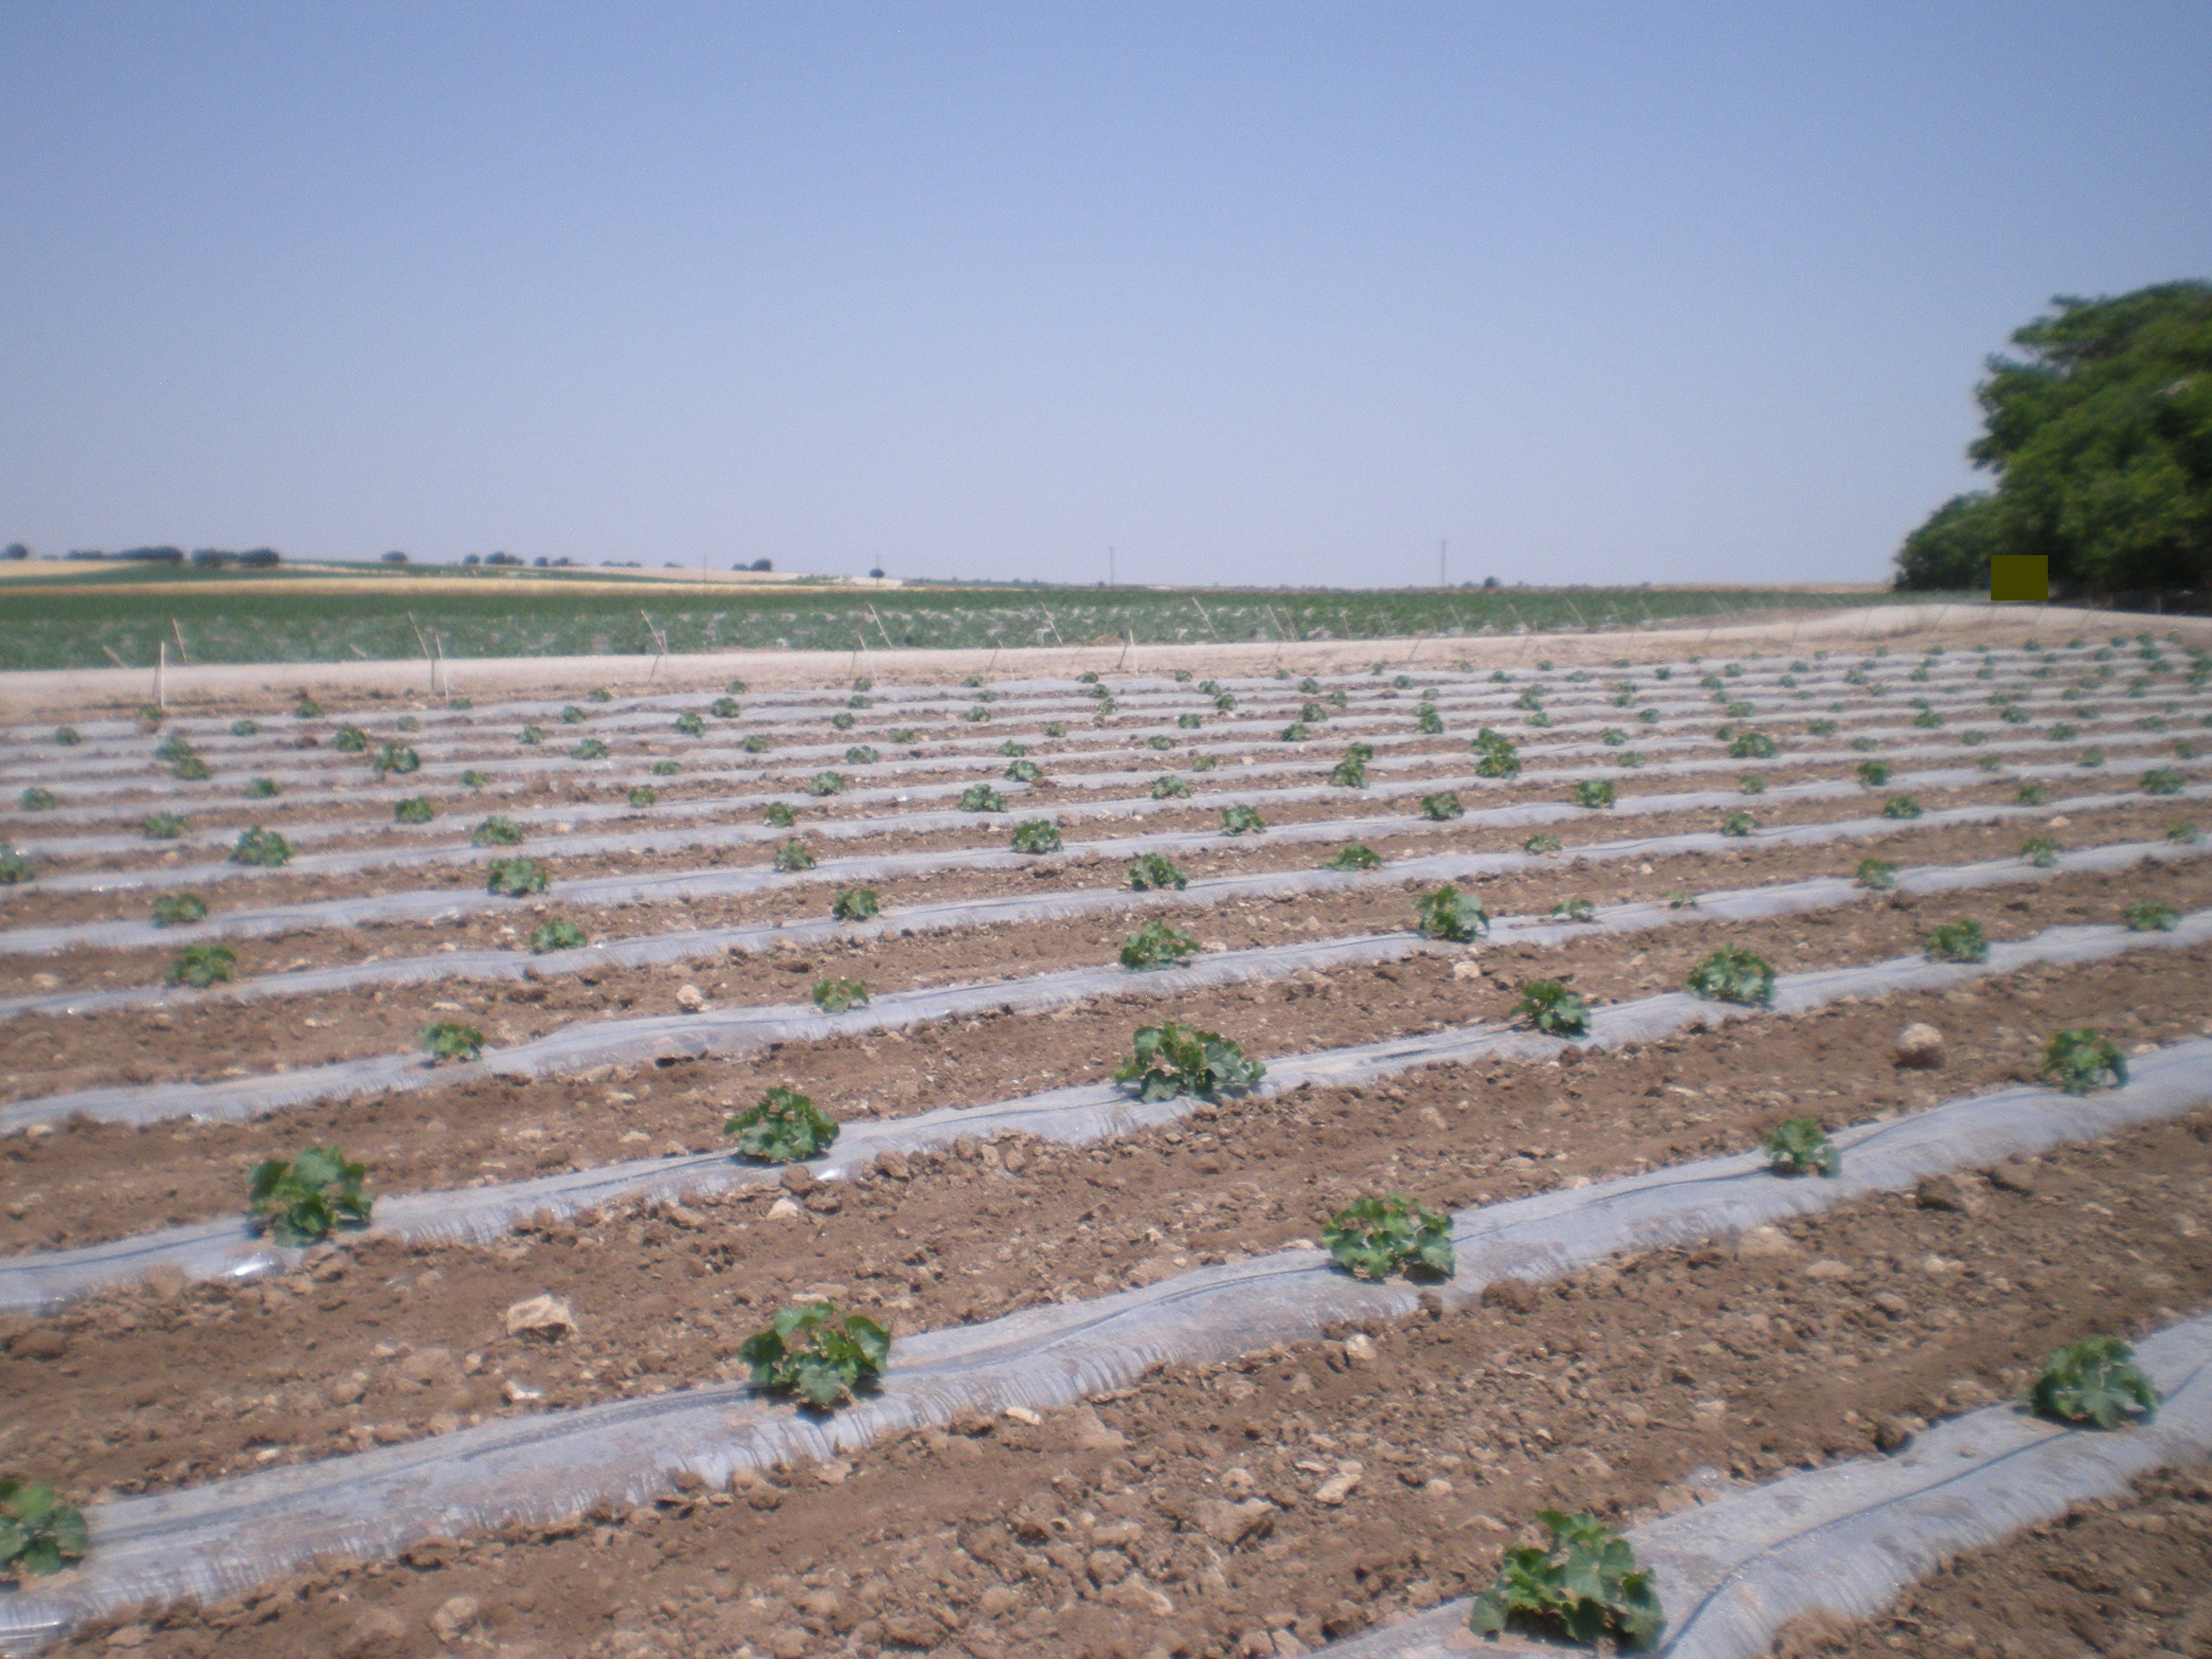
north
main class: Cropland
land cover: Other fresh vegetables
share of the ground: < 10 %
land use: Agriculture (excluding fallow land and kitchen gardens)
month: June
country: ES
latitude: 39.6666
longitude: -3.1818
